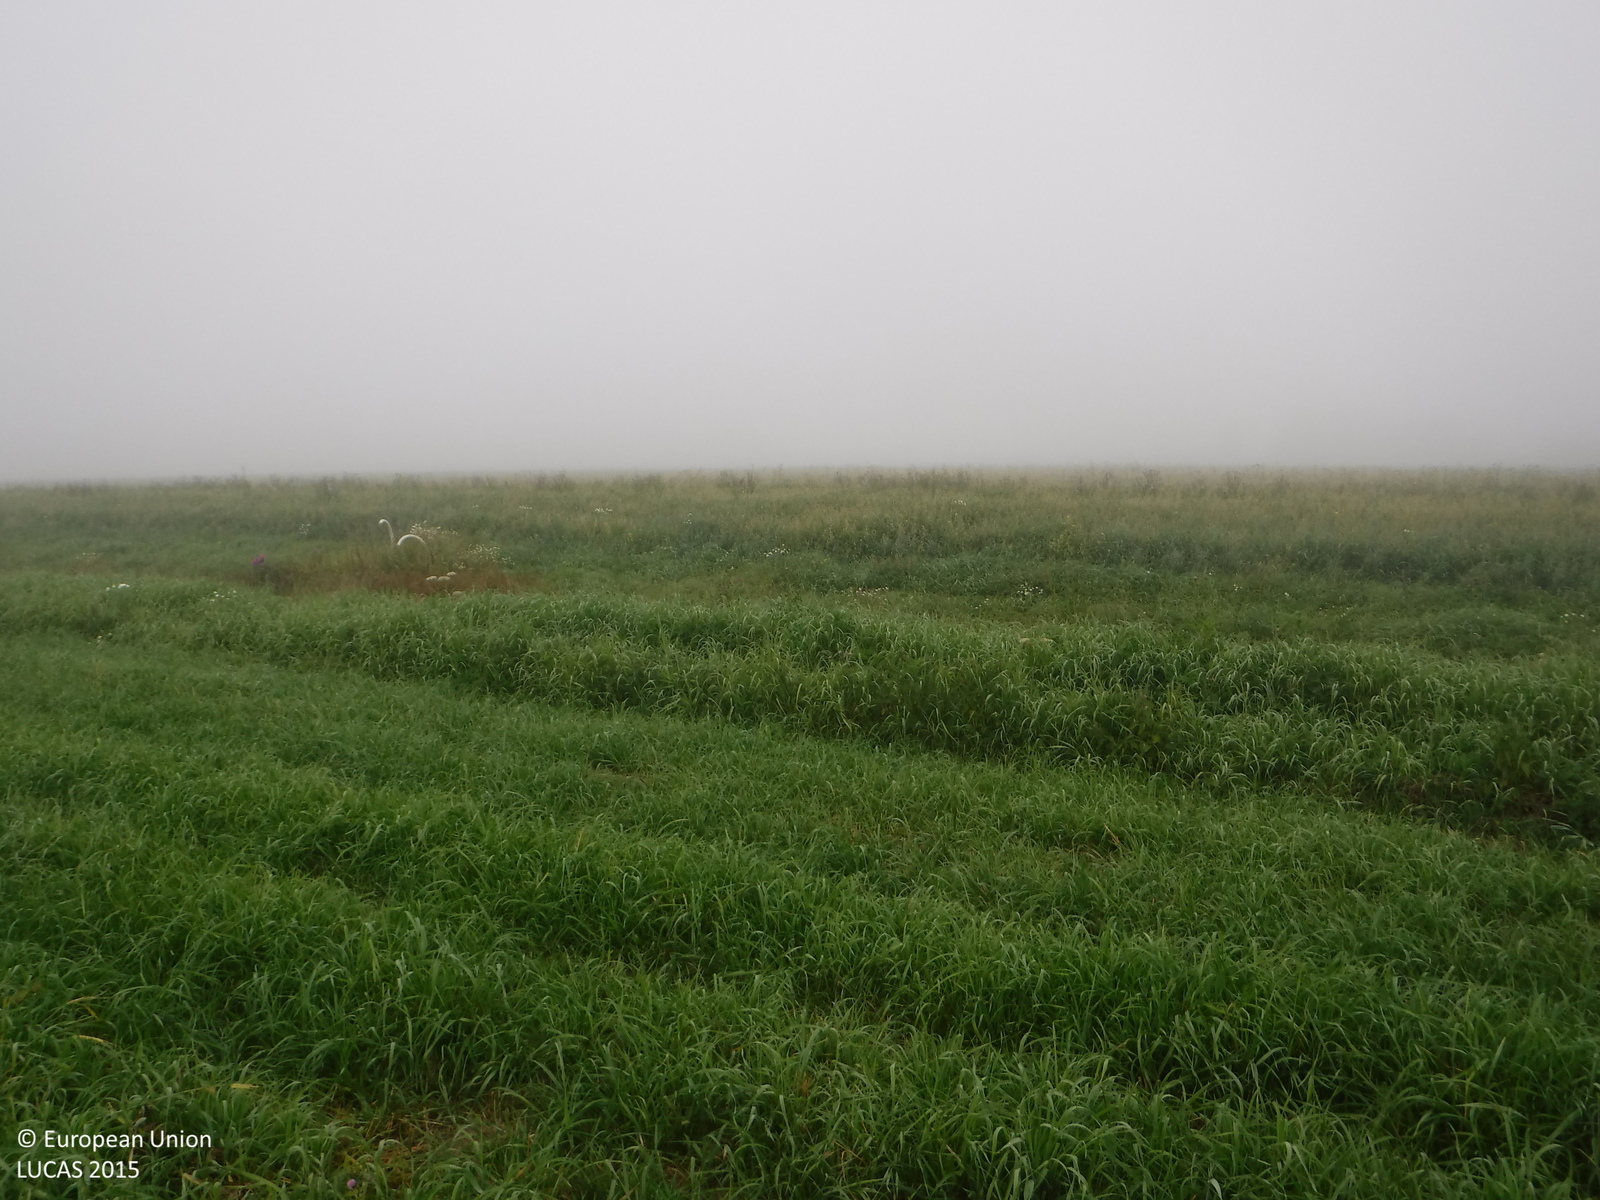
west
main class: Cropland
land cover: Potatoes
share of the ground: 25 - 50 %
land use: Agriculture (excluding fallow land and kitchen gardens)
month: August
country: FI
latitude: 61.2065
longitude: 22.5548
